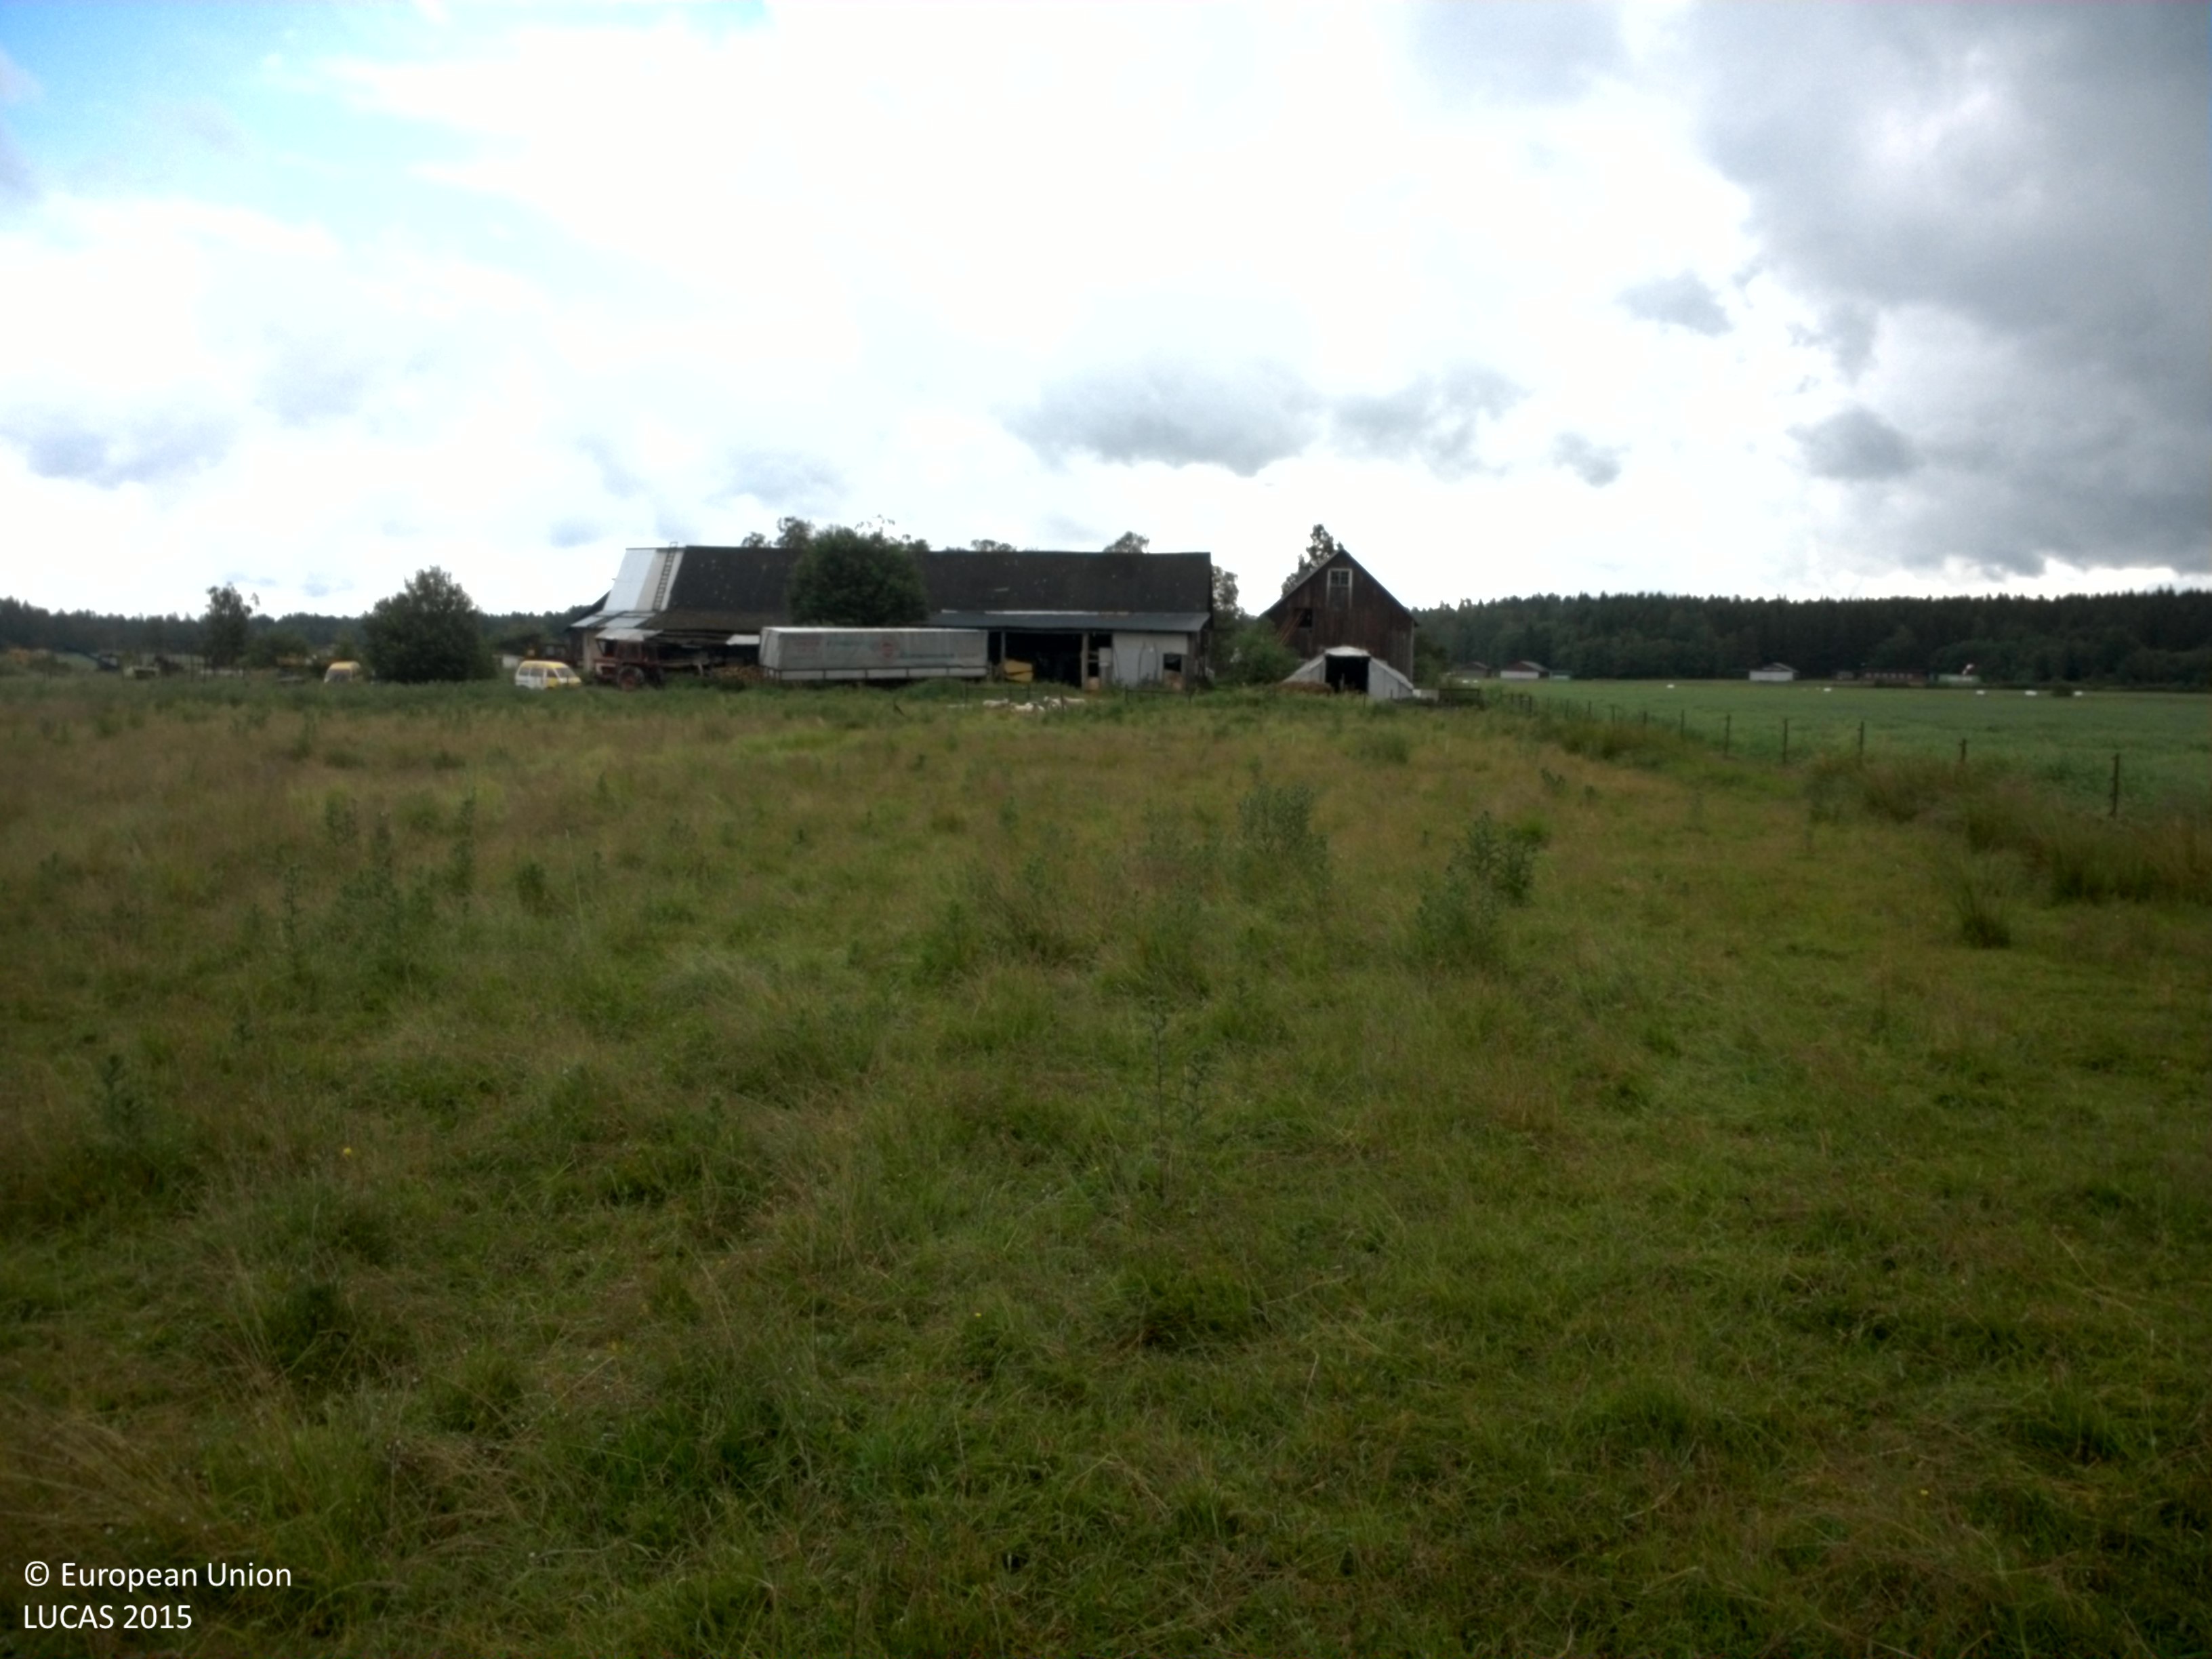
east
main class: Grassland
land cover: Grassland without tree/shrub cover
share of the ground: > 75 %
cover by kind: herbaceous plants 100 %
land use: Agriculture (excluding fallow land and kitchen gardens)
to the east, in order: Grassland without tree/shrub cover; Artificial constructions in urban areas; Broadleaved woodland; Grassland without tree/shrub cover; Fences; Mixed cereals for fodder
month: July
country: SE
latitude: 58.1963
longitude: 13.9921
